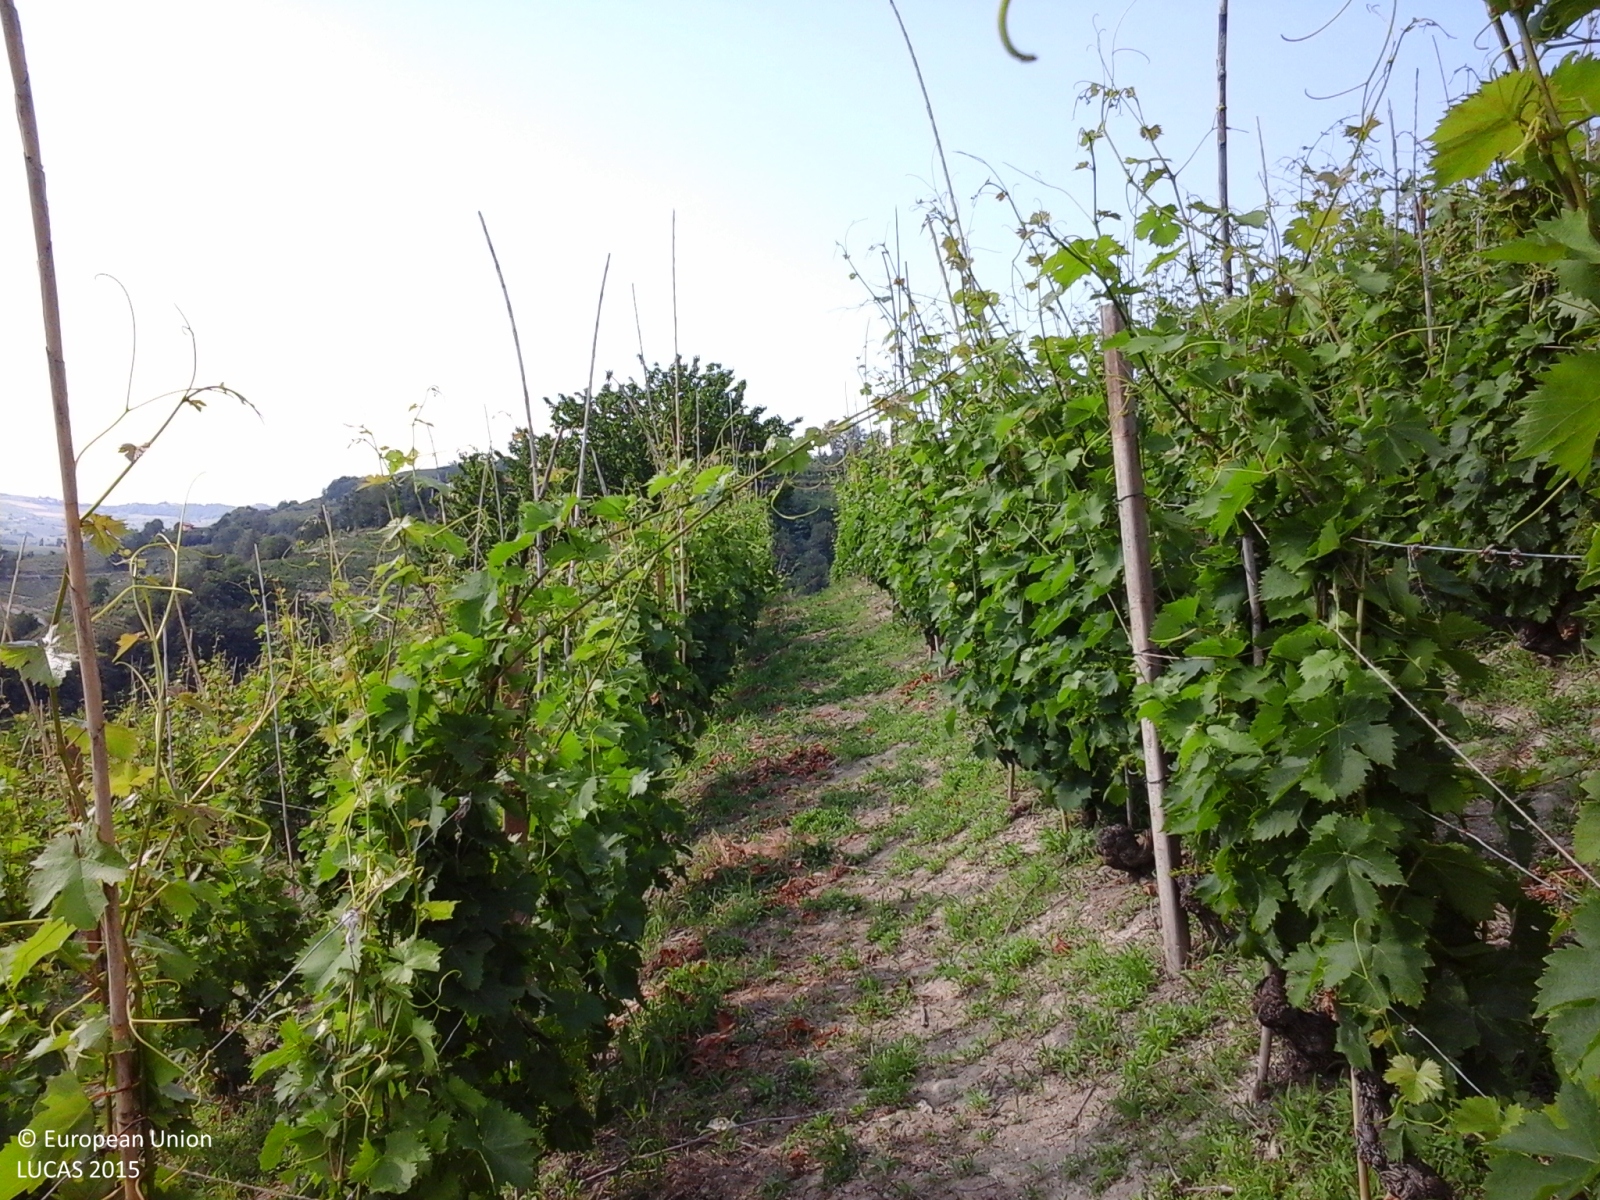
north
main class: Cropland
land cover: Vineyards
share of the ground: 25 - 50 %
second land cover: Grassland without tree/shrub cover
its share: 50 - 75 %
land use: Agriculture (excluding fallow land and kitchen gardens)
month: June
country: IT
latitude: 44.7322
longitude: 8.2231
